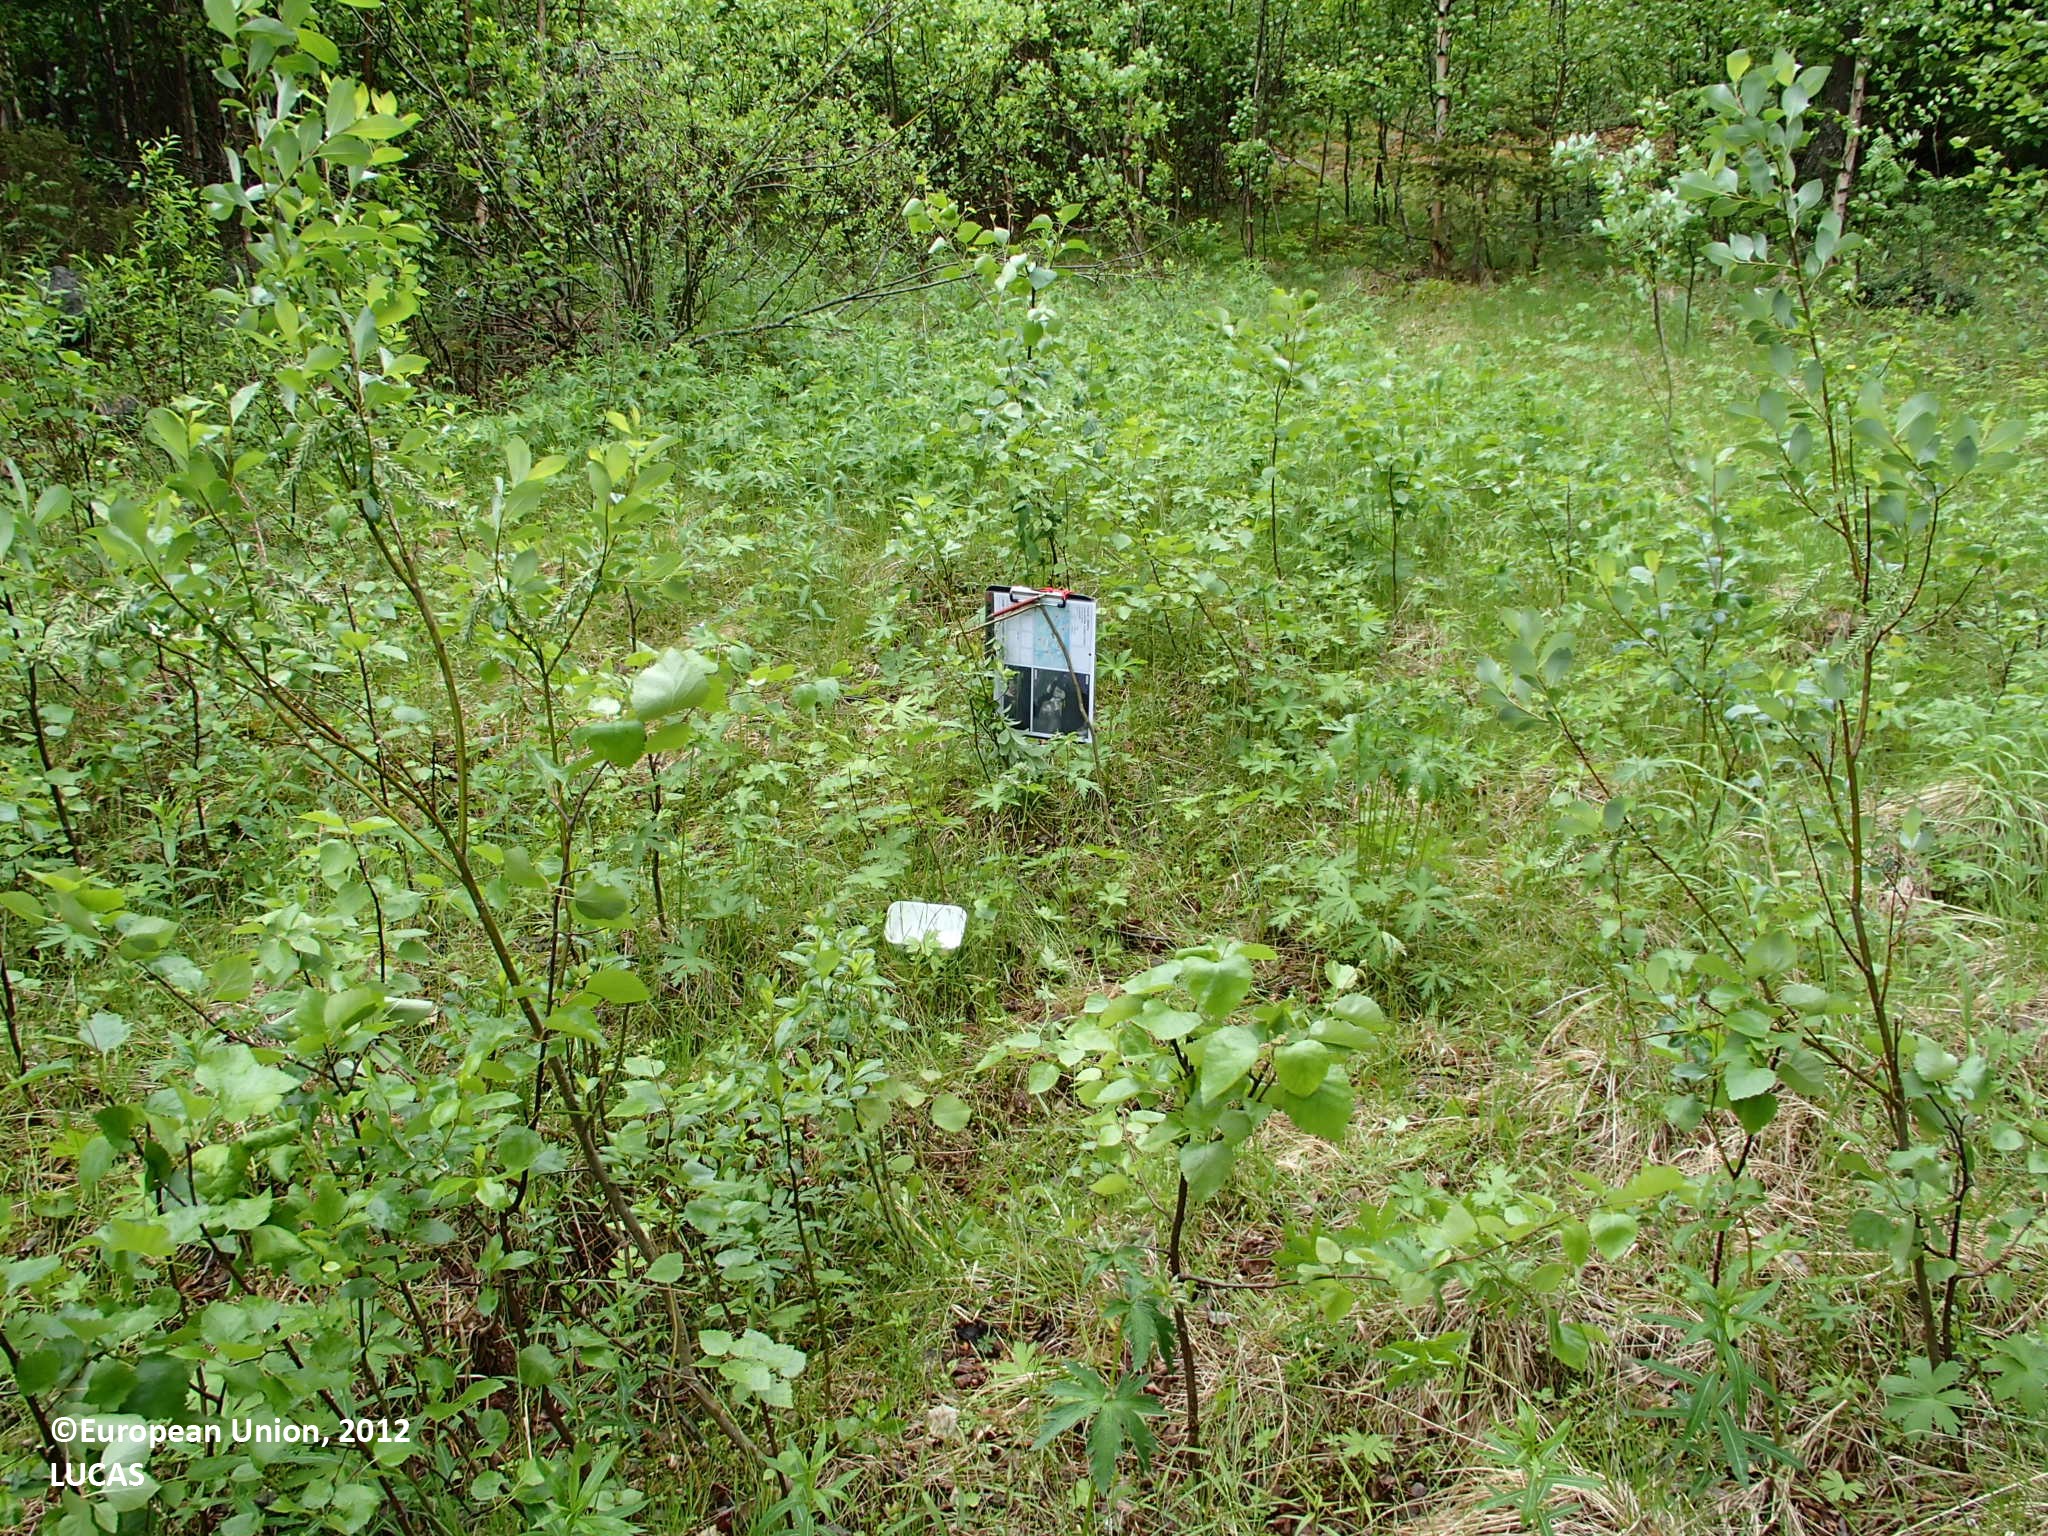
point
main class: Woodland
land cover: Broadleaved woodland
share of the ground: 25 - 50 %
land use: Forestry
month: June
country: FI
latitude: 66.4736
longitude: 27.2828
